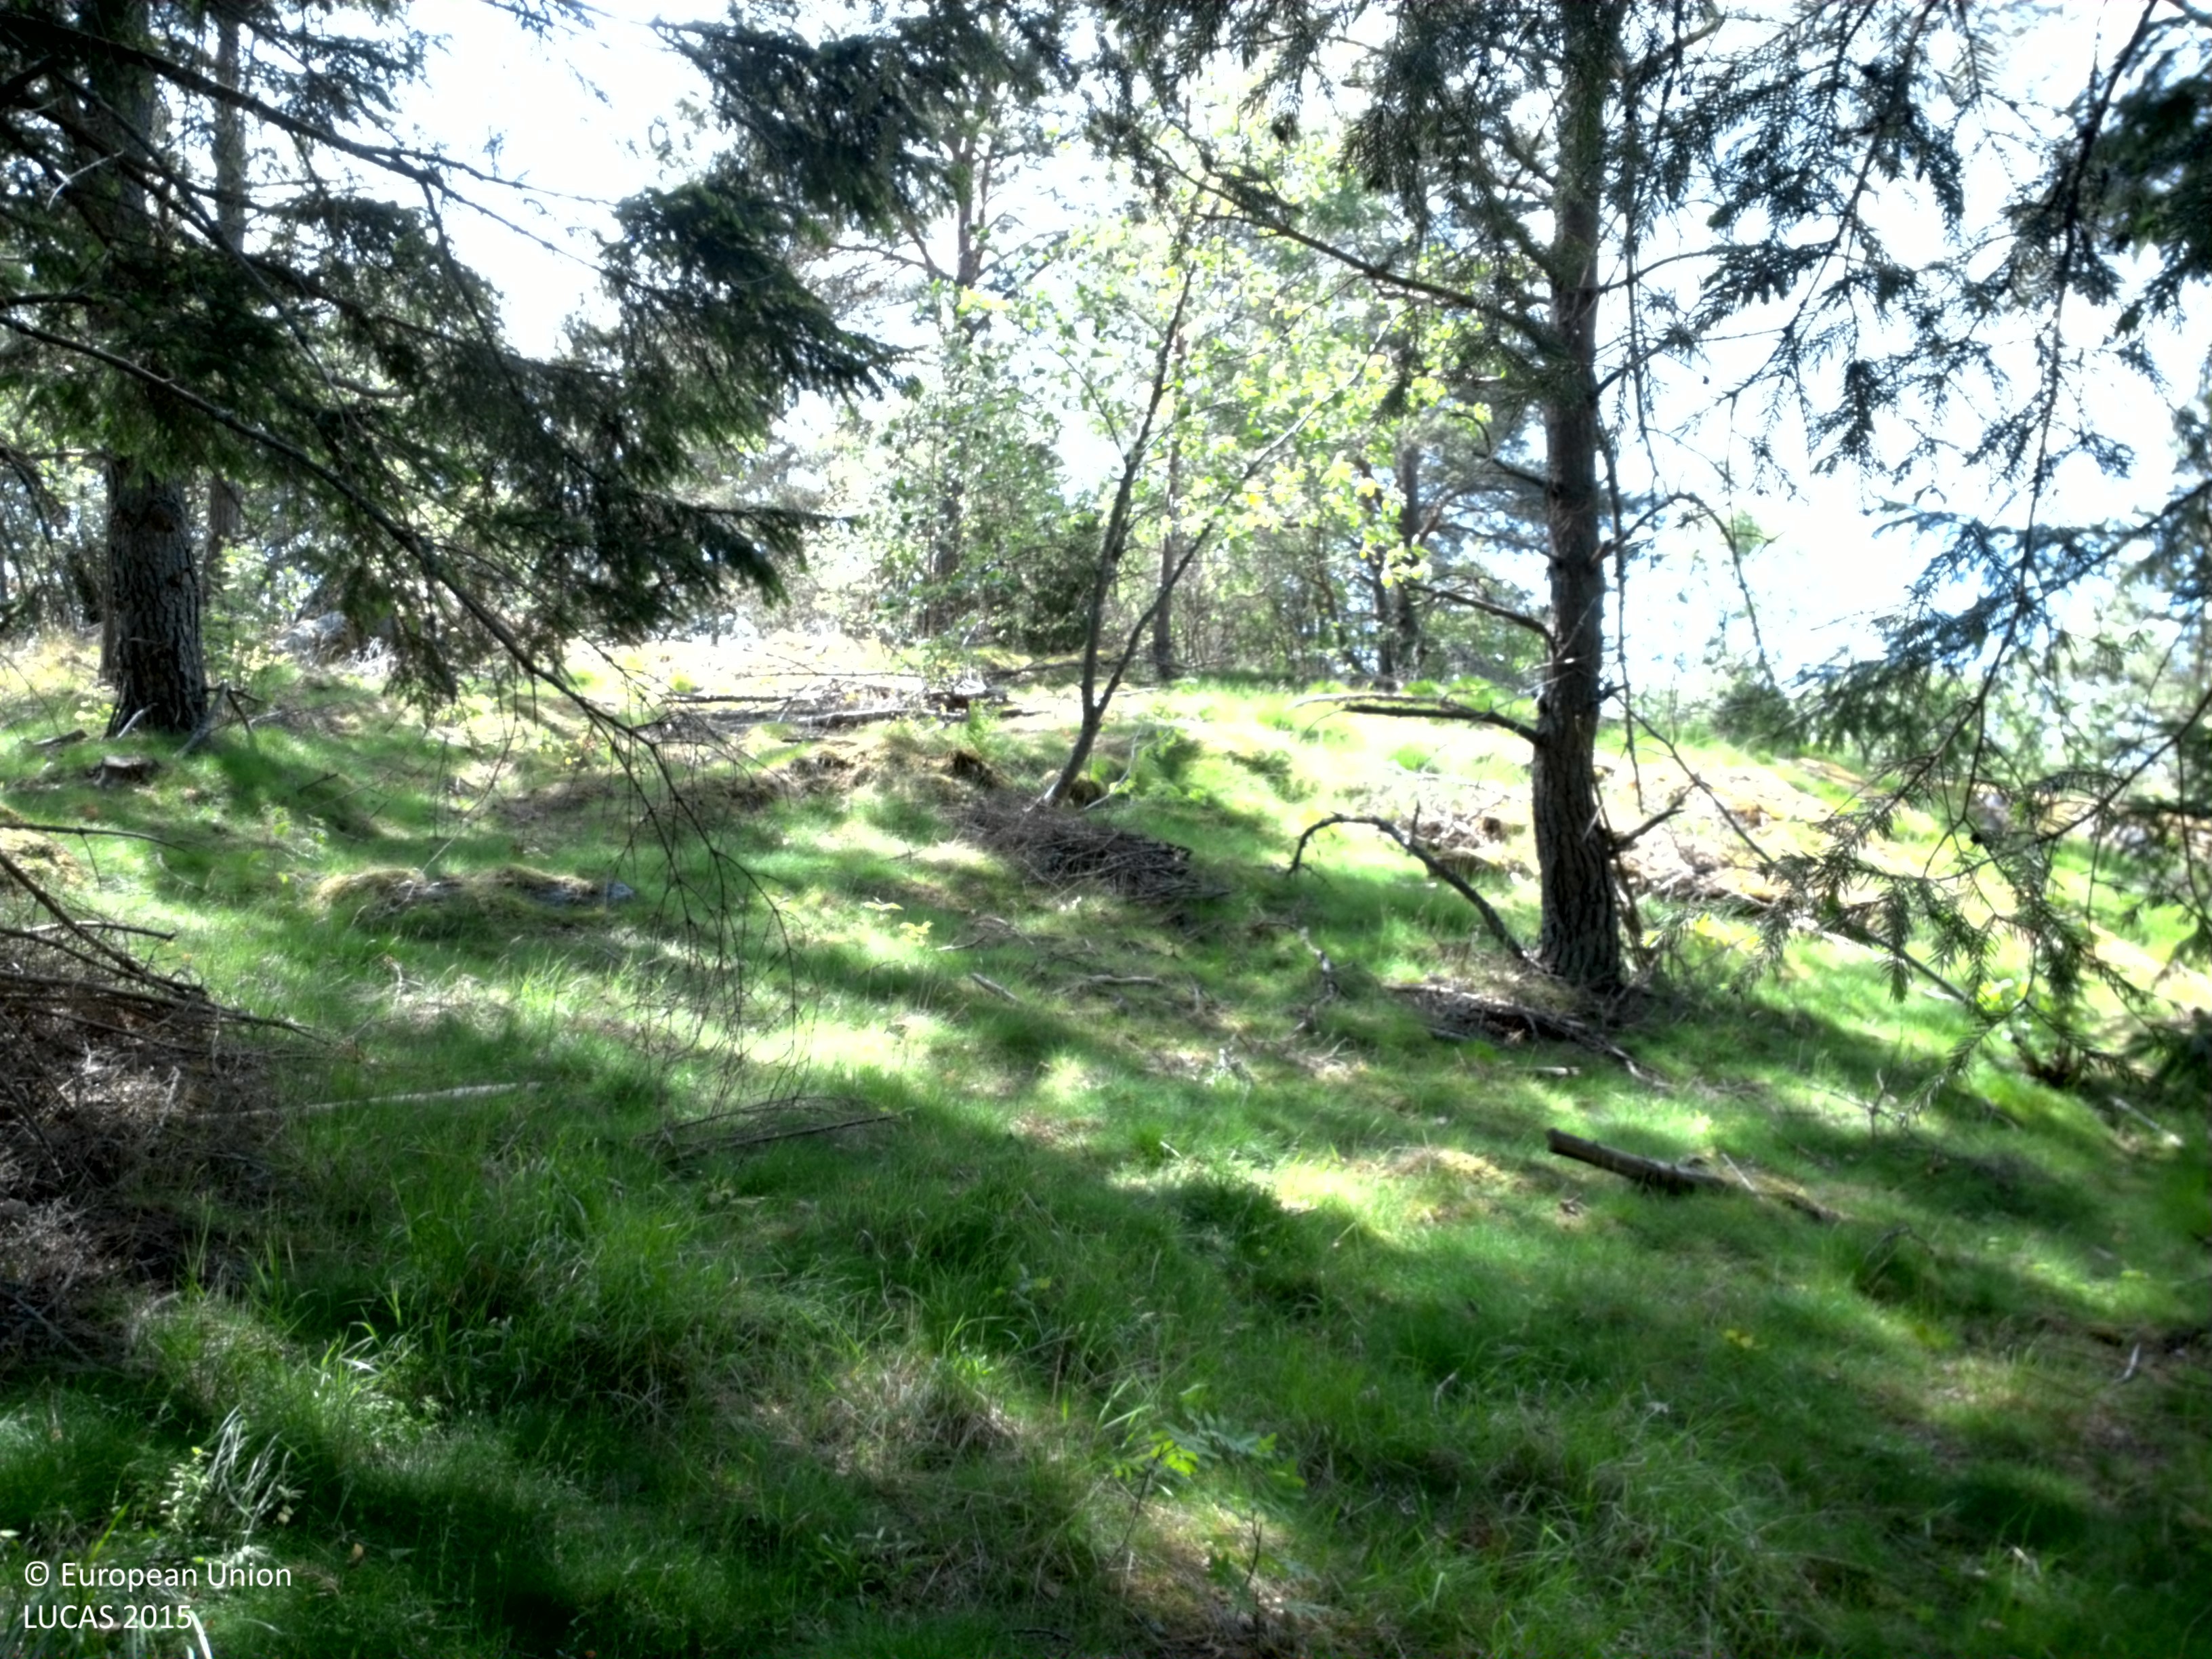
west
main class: Woodland
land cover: Spruce dominated coniferous woodland
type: boreal forest
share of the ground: 50 - 75 %
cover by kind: coniferous forest trees 50 %, lichens and mosses 30 %, herbaceous plants 15 %, broadleaved forest trees 5 %
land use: Forestry
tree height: > 5 m
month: June
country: SE
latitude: 58.4726
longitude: 16.2194
